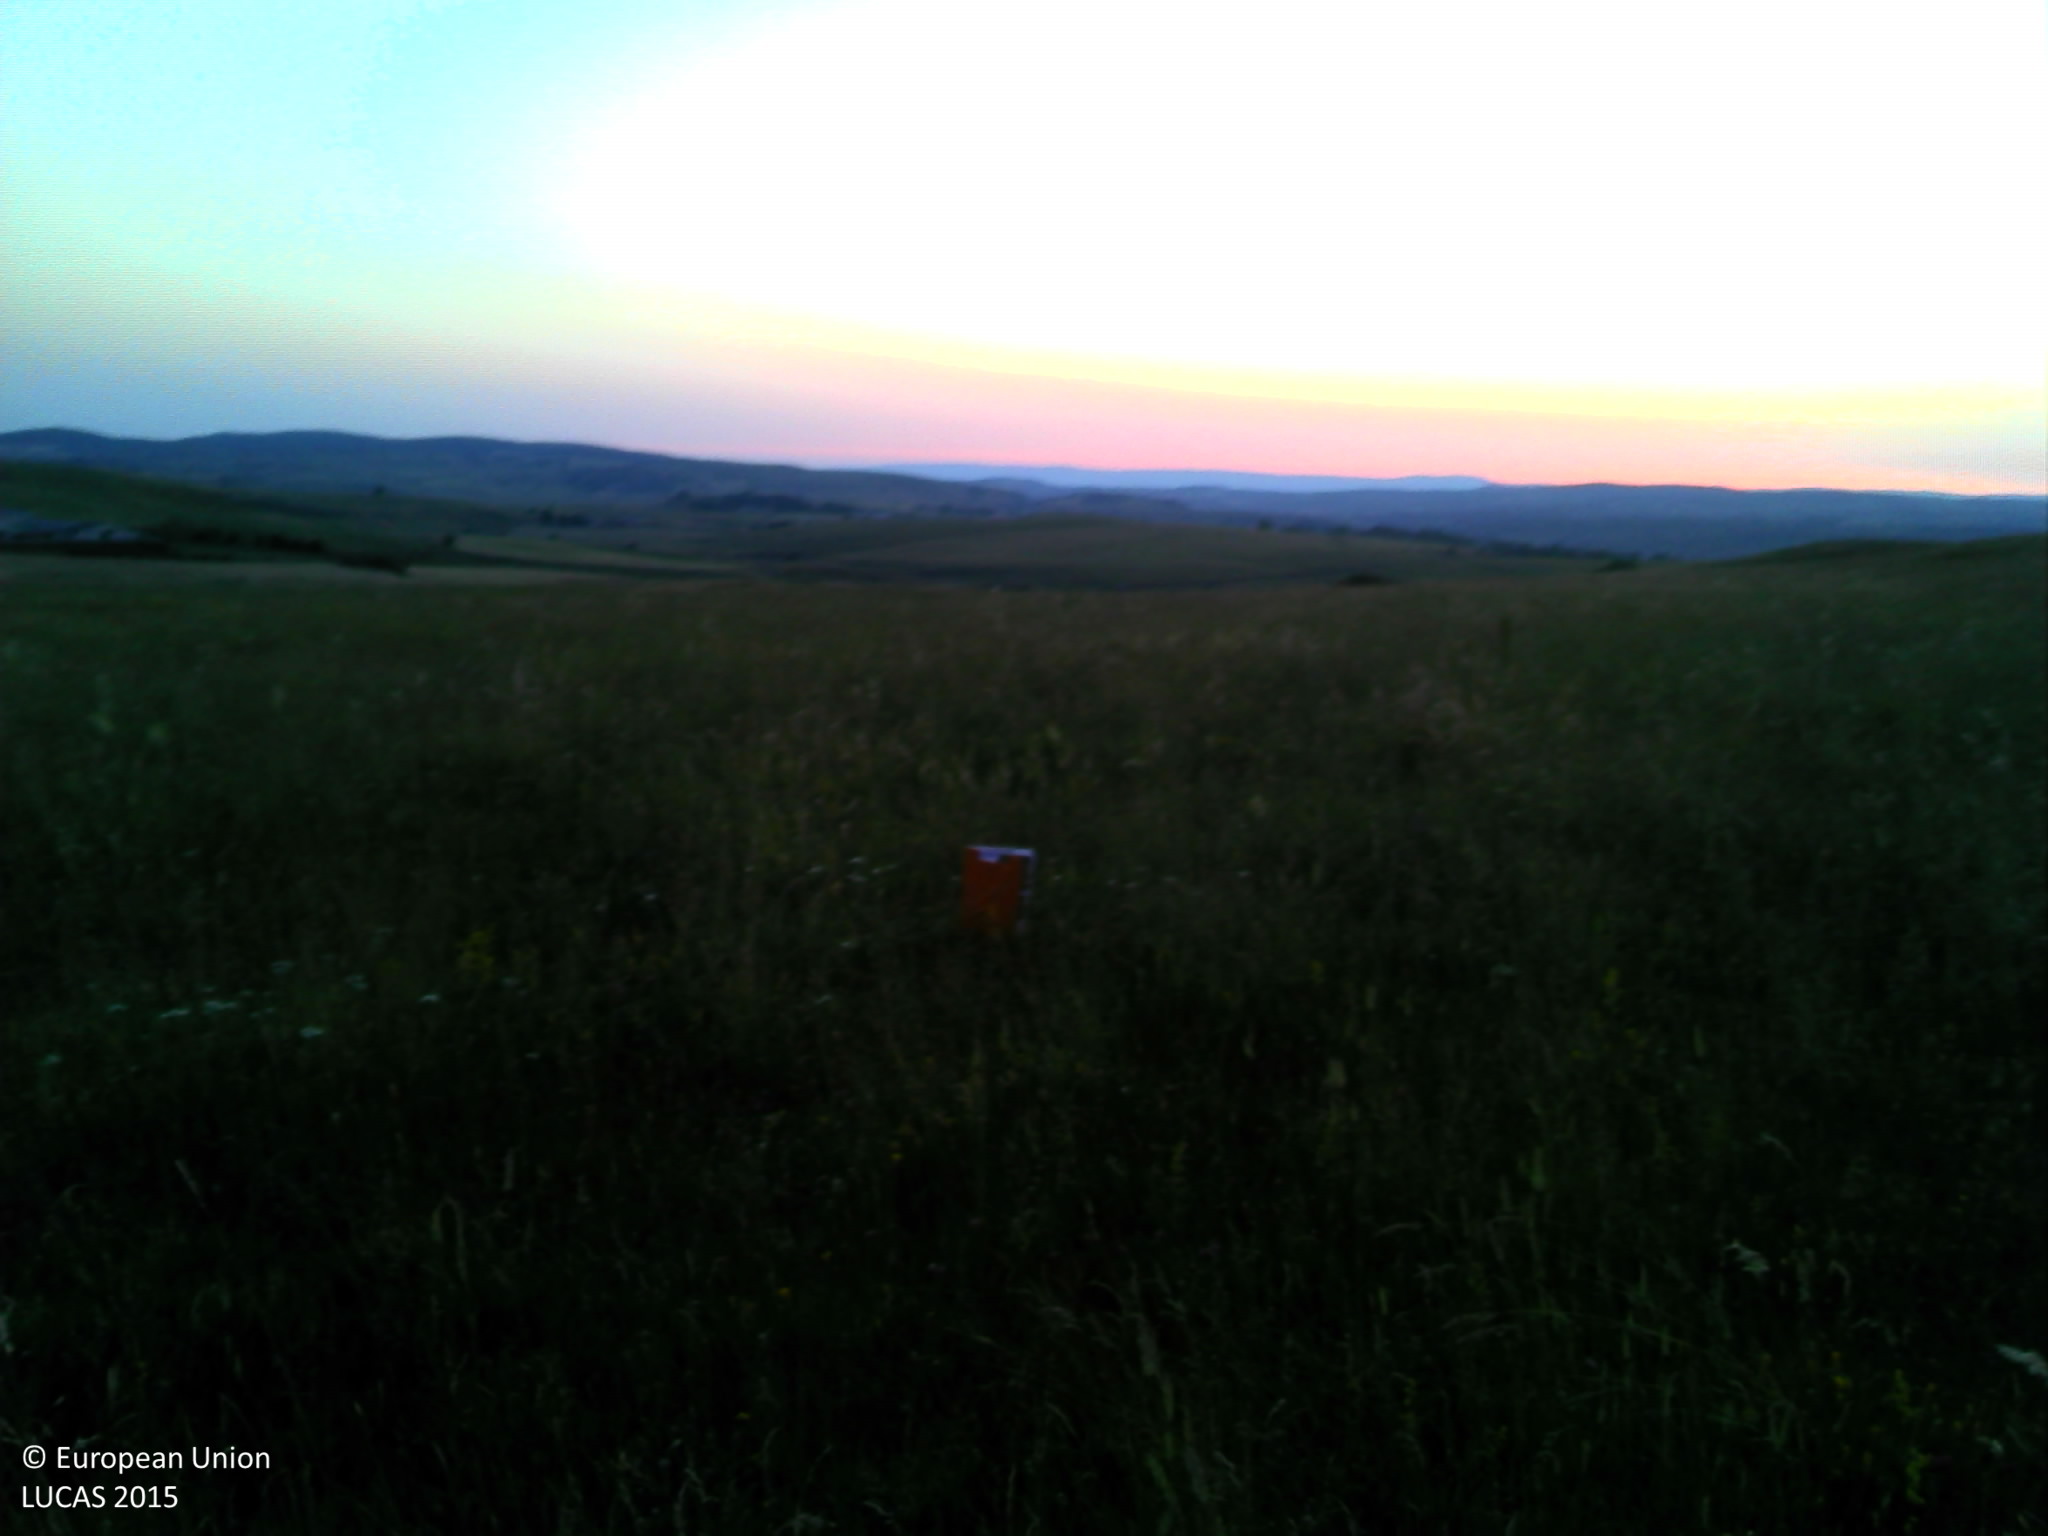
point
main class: Grassland
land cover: Grassland without tree/shrub cover
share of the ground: > 75 %
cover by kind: herbaceous plants 100 %
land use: Agriculture (excluding fallow land and kitchen gardens)
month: July
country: FR
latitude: 44.6914
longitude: 2.9748
